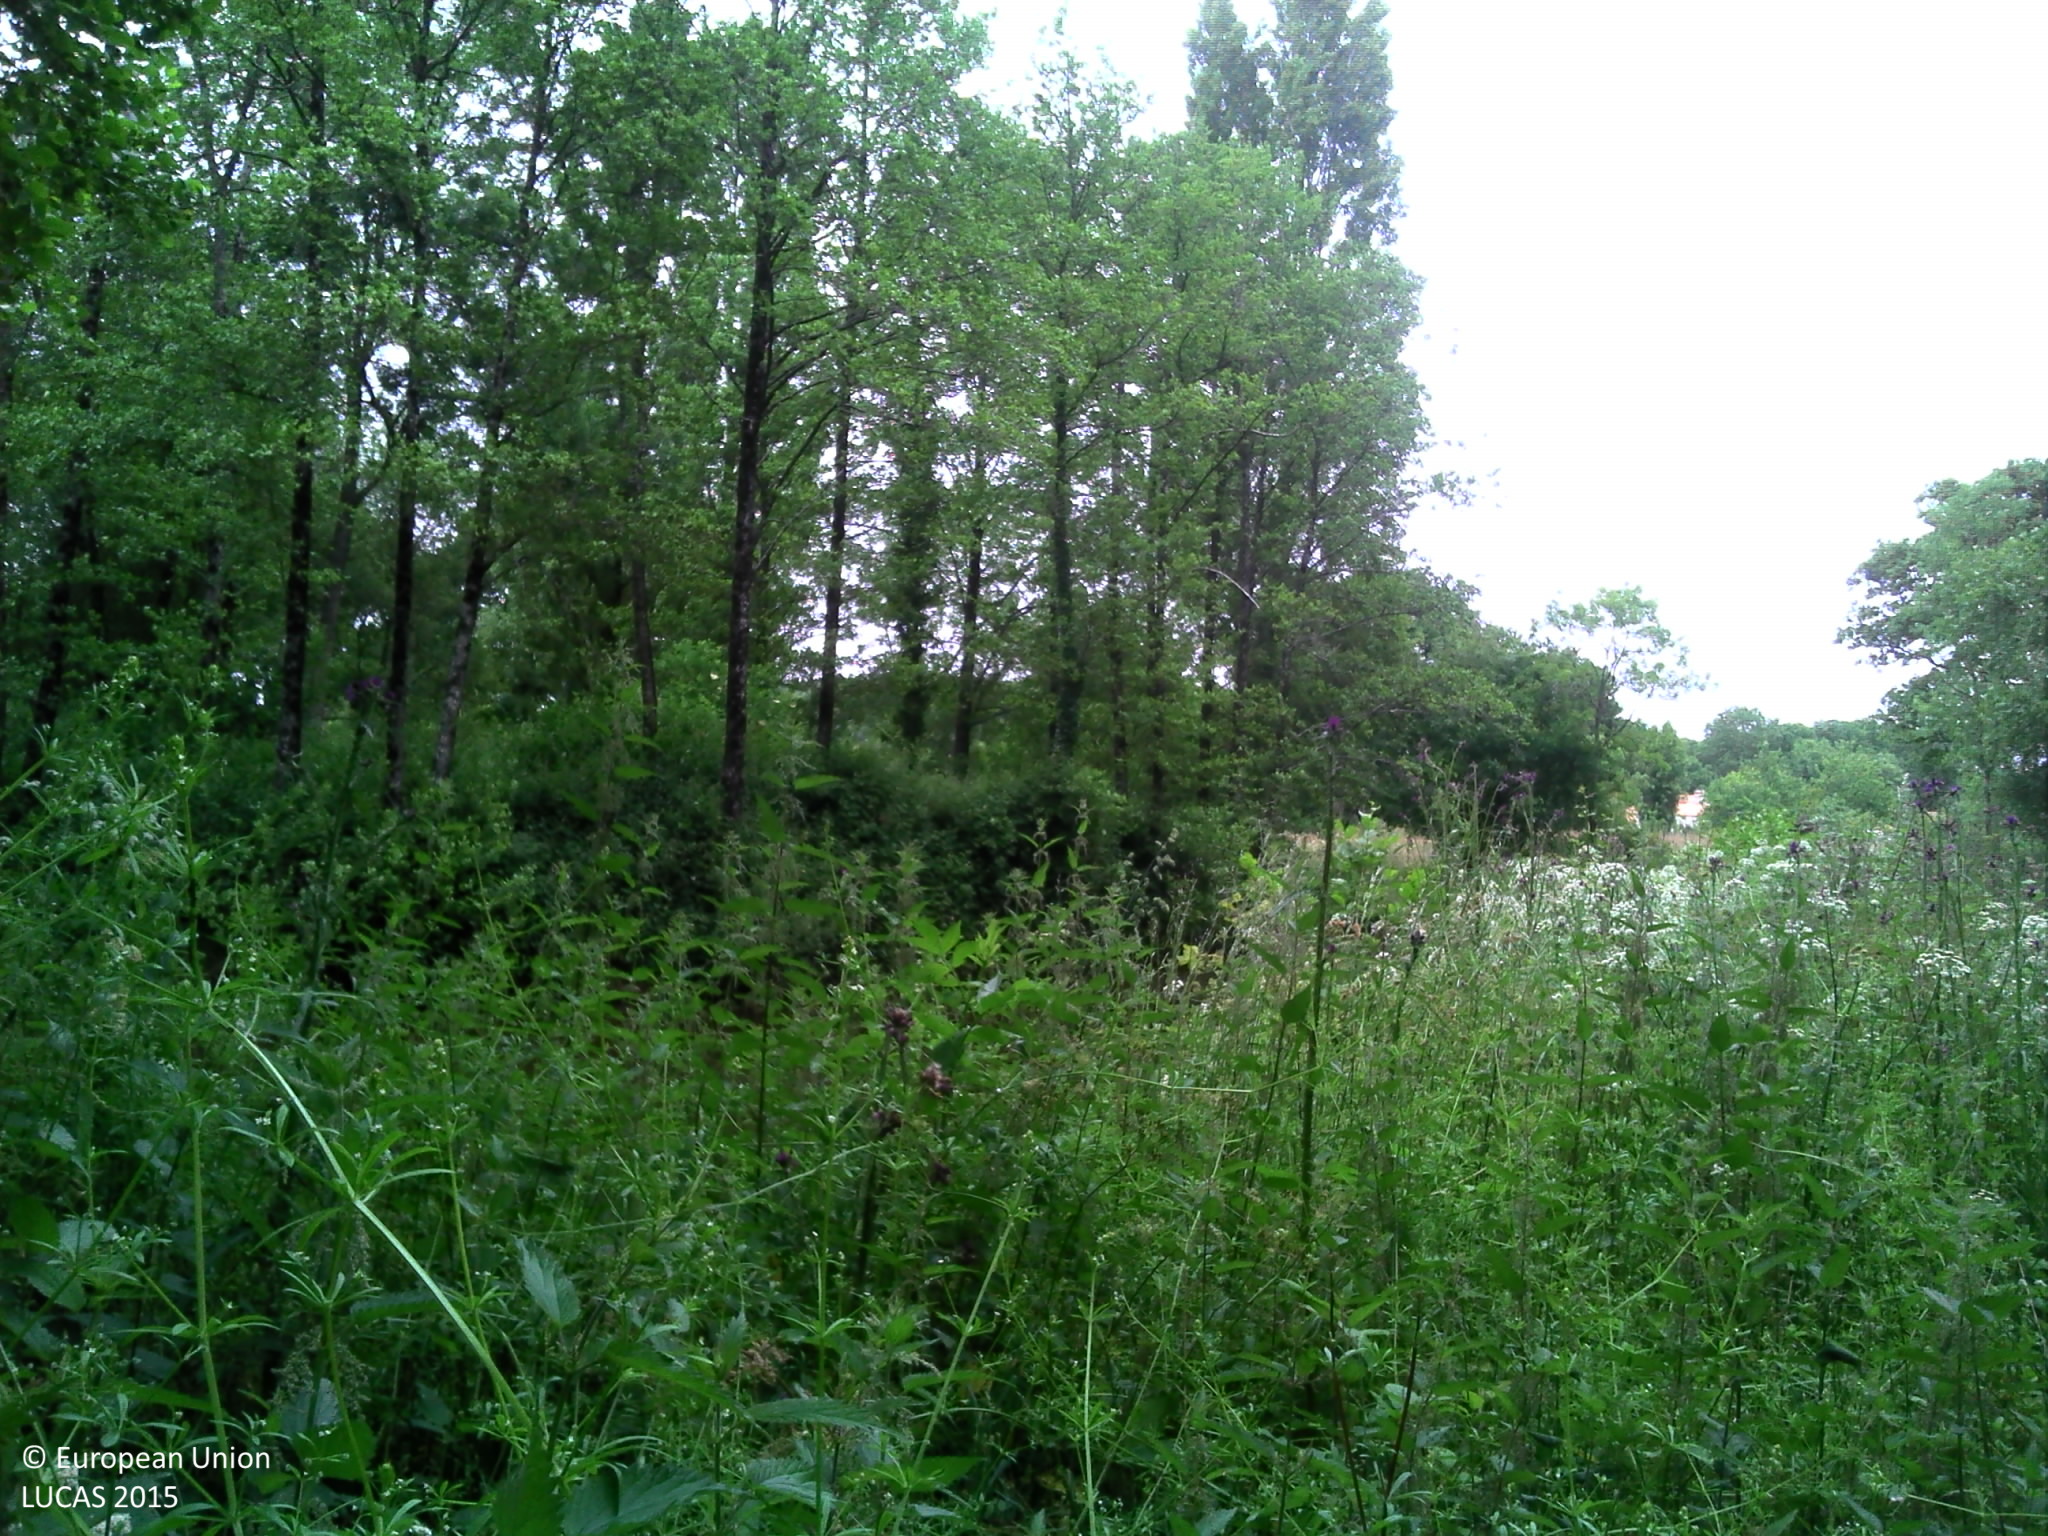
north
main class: Grassland
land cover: Spontaneously vegetated surfaces
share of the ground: > 75 %
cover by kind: herbaceous plants 95 %, shrubs 5 %
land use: Semi-natural and natural areas not in use
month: June
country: FR
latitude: 46.8382
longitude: -1.8313
